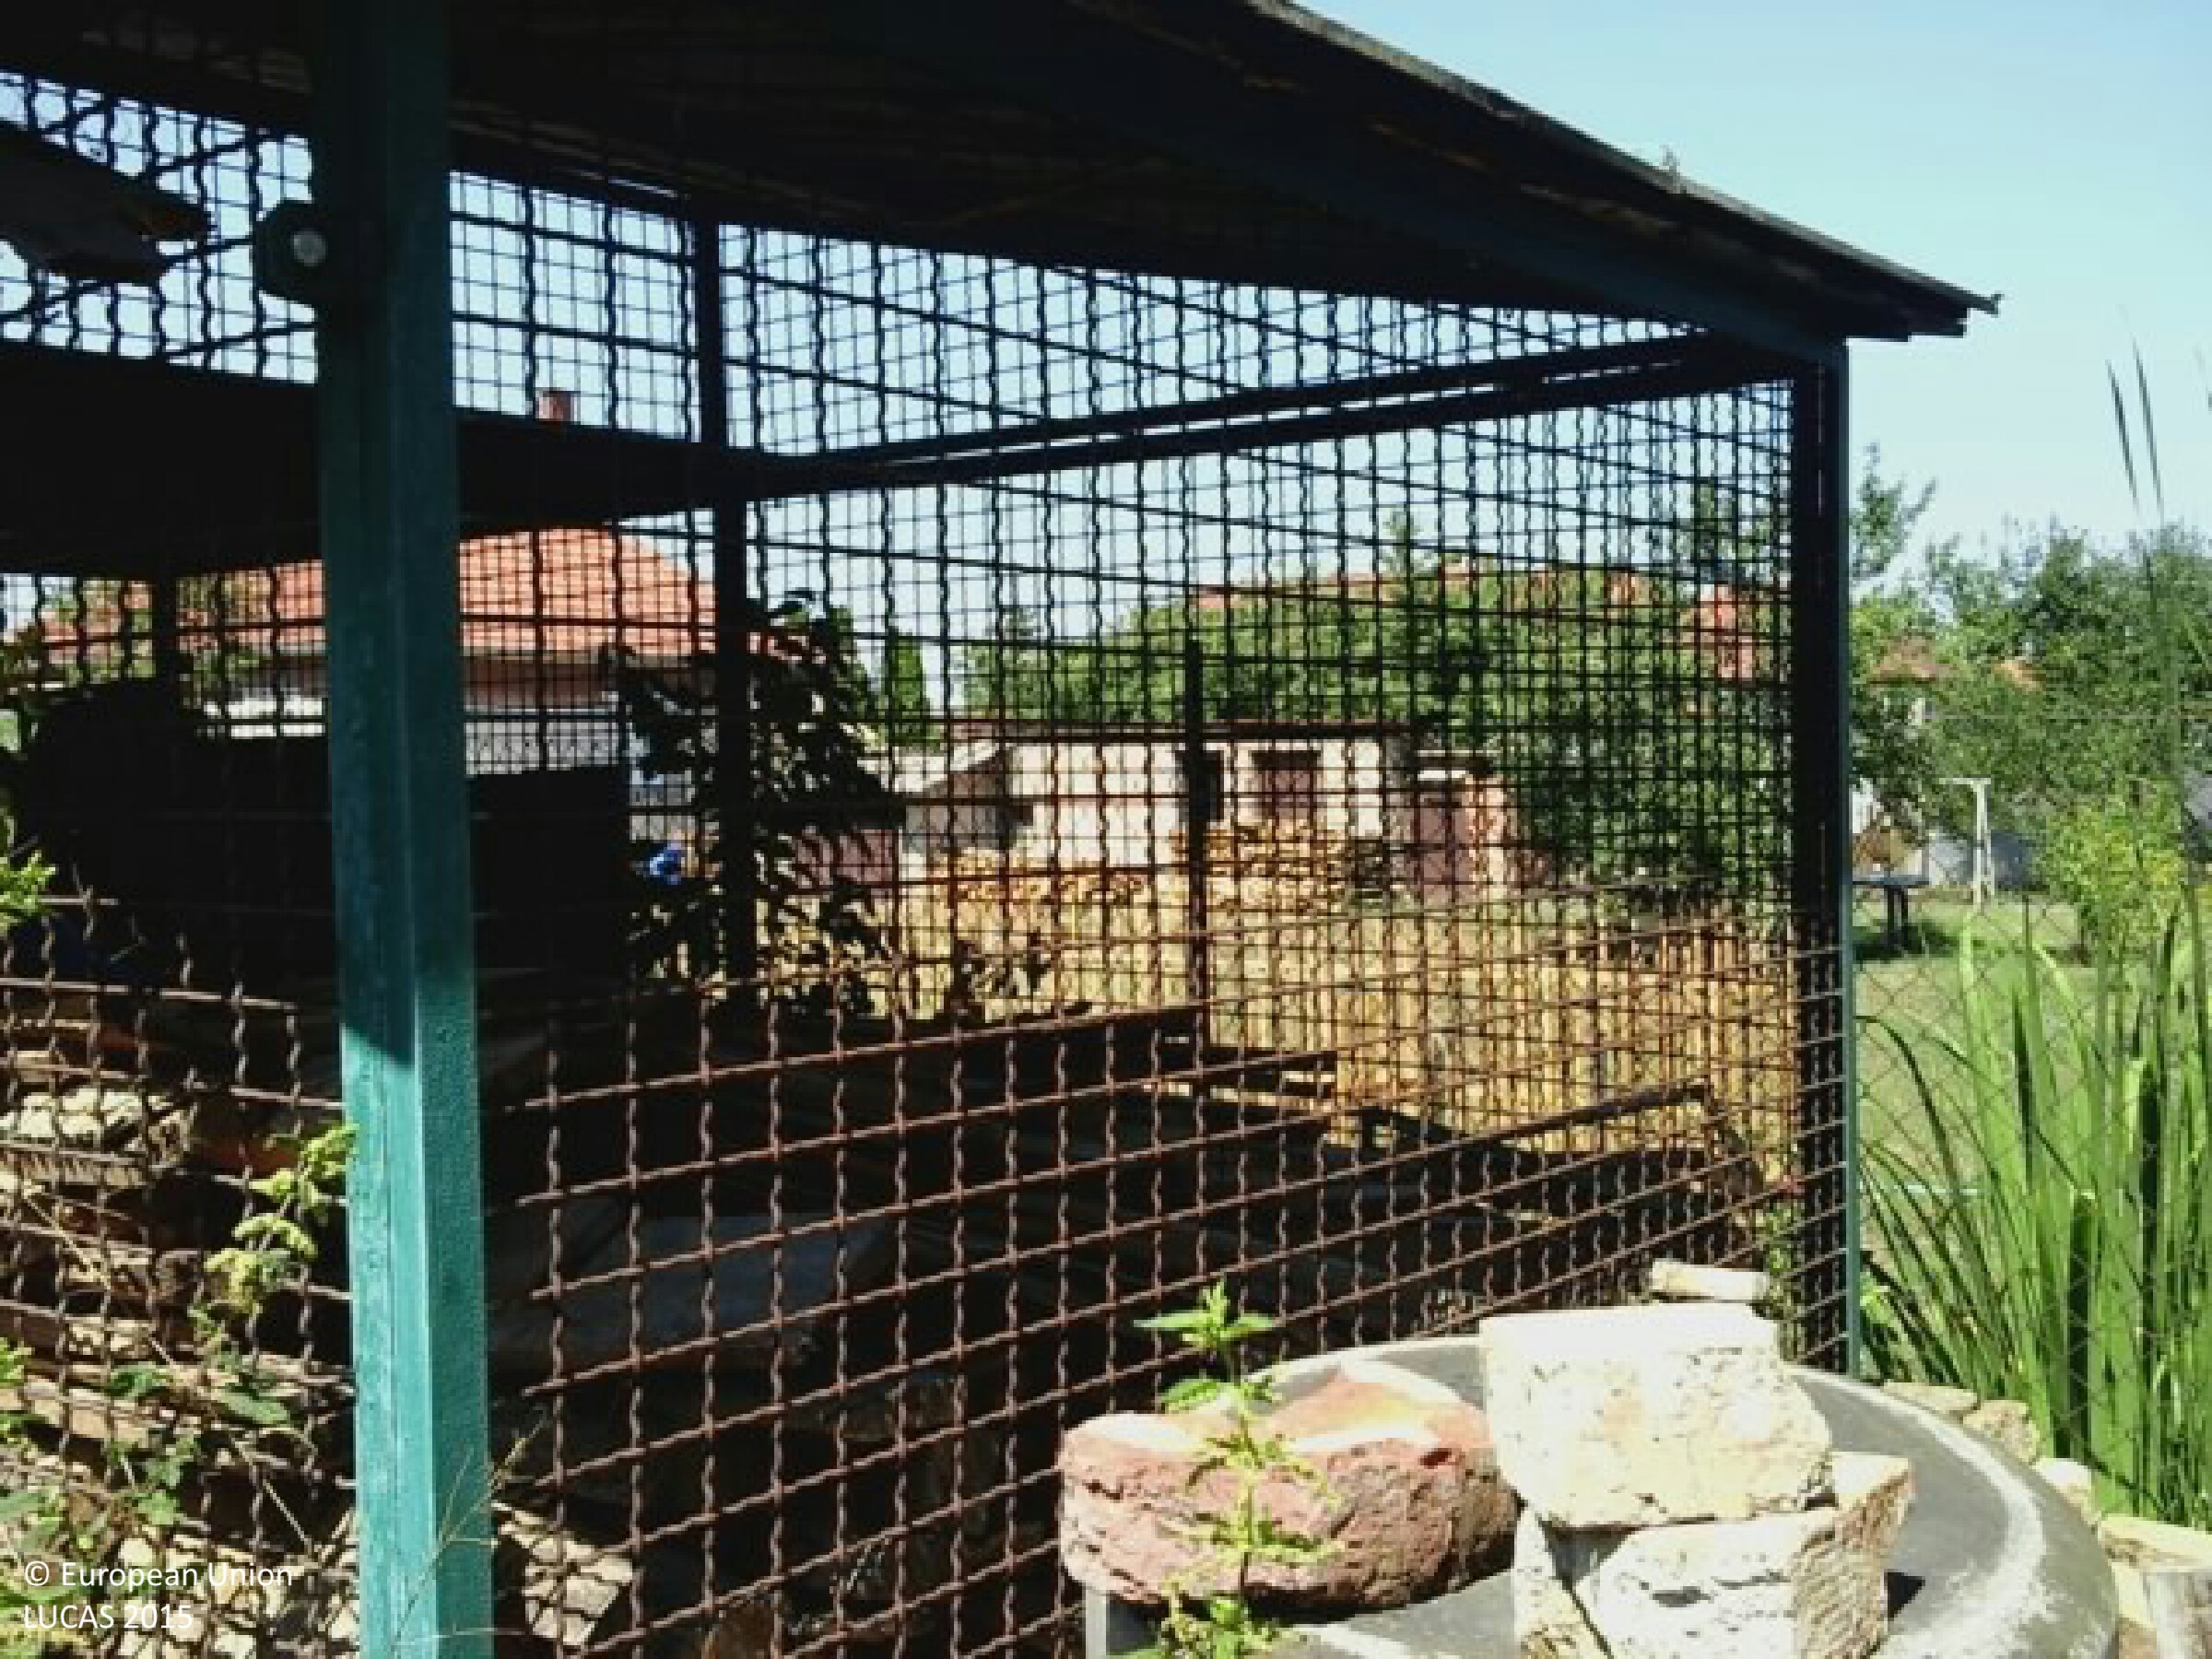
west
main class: Grassland
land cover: Grassland with sparse tree/shrub cover
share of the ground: 25 - 50 %
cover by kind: herbaceous plants 85 %, shrubs 10 %, broadleaved forest trees 5 %
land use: Residential
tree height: < 5 m
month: July
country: HU
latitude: 48.2568
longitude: 20.7723
